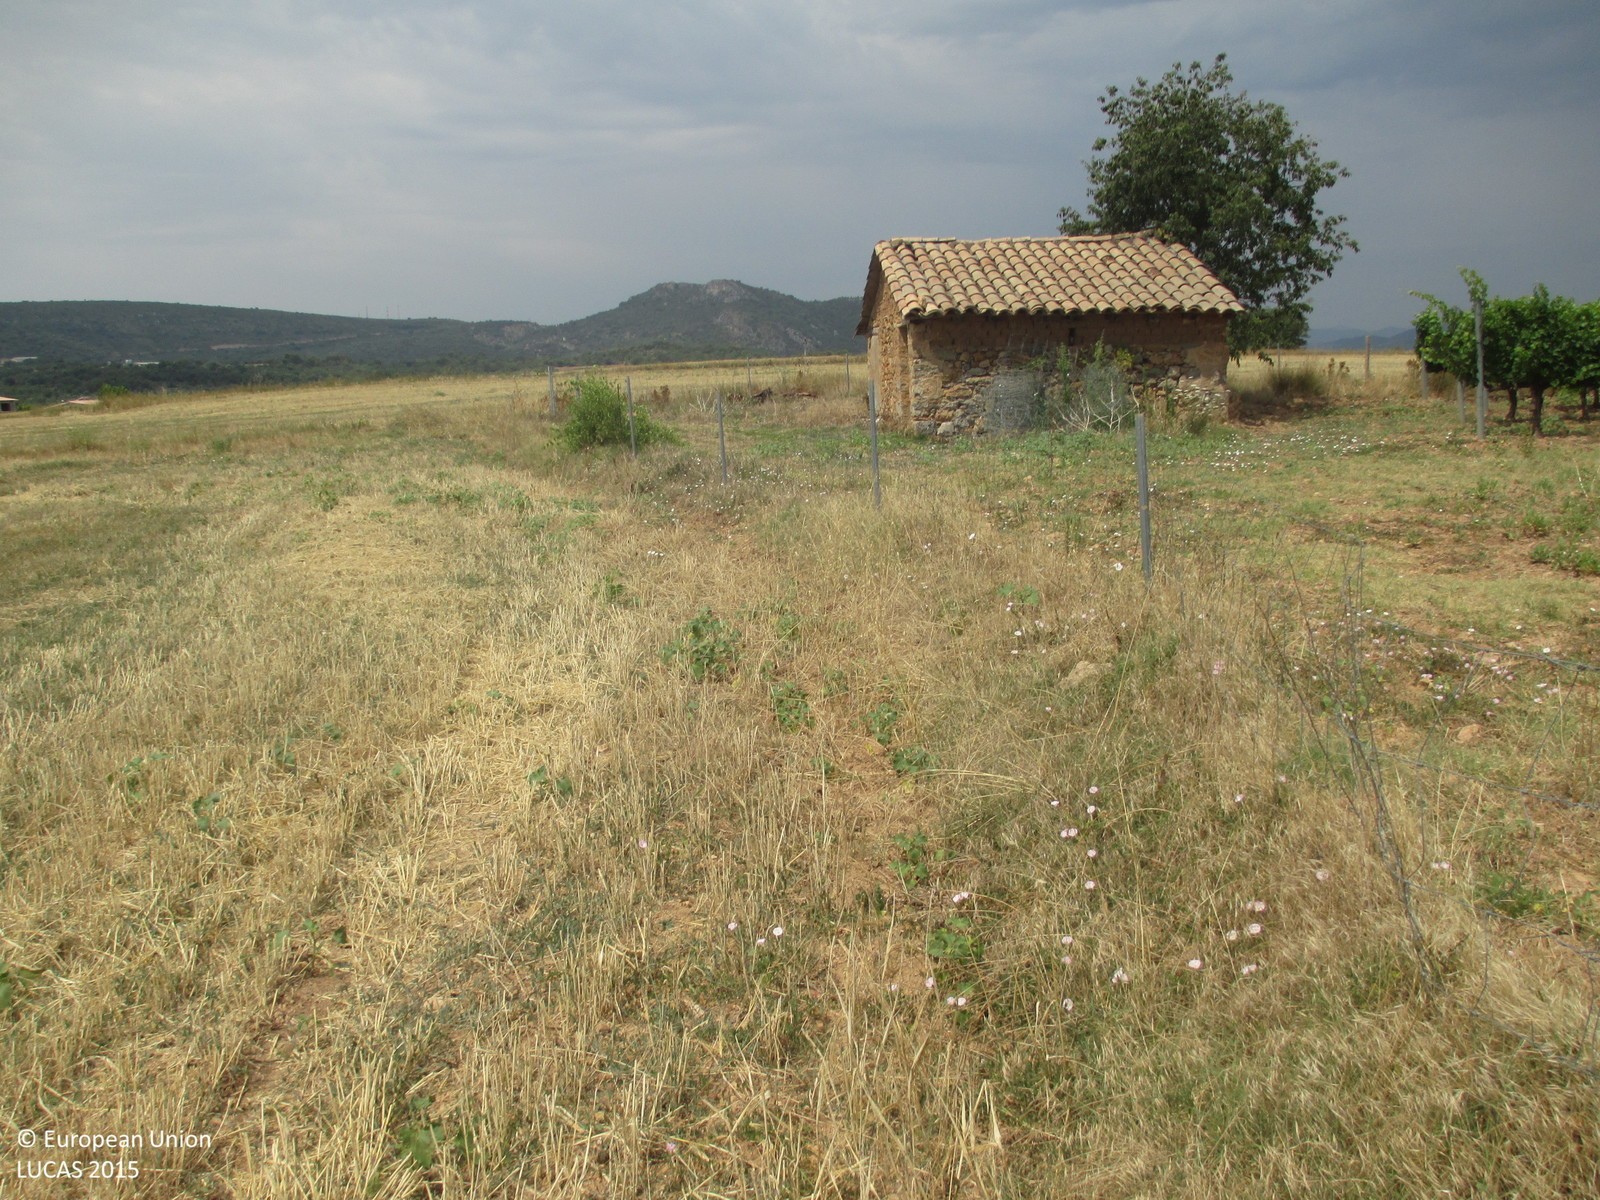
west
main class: Cropland
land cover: Barley
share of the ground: < 10 %
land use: Agriculture (excluding fallow land and kitchen gardens)
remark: Harvested field
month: July
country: ES
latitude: 42.1679
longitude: 0.2858
